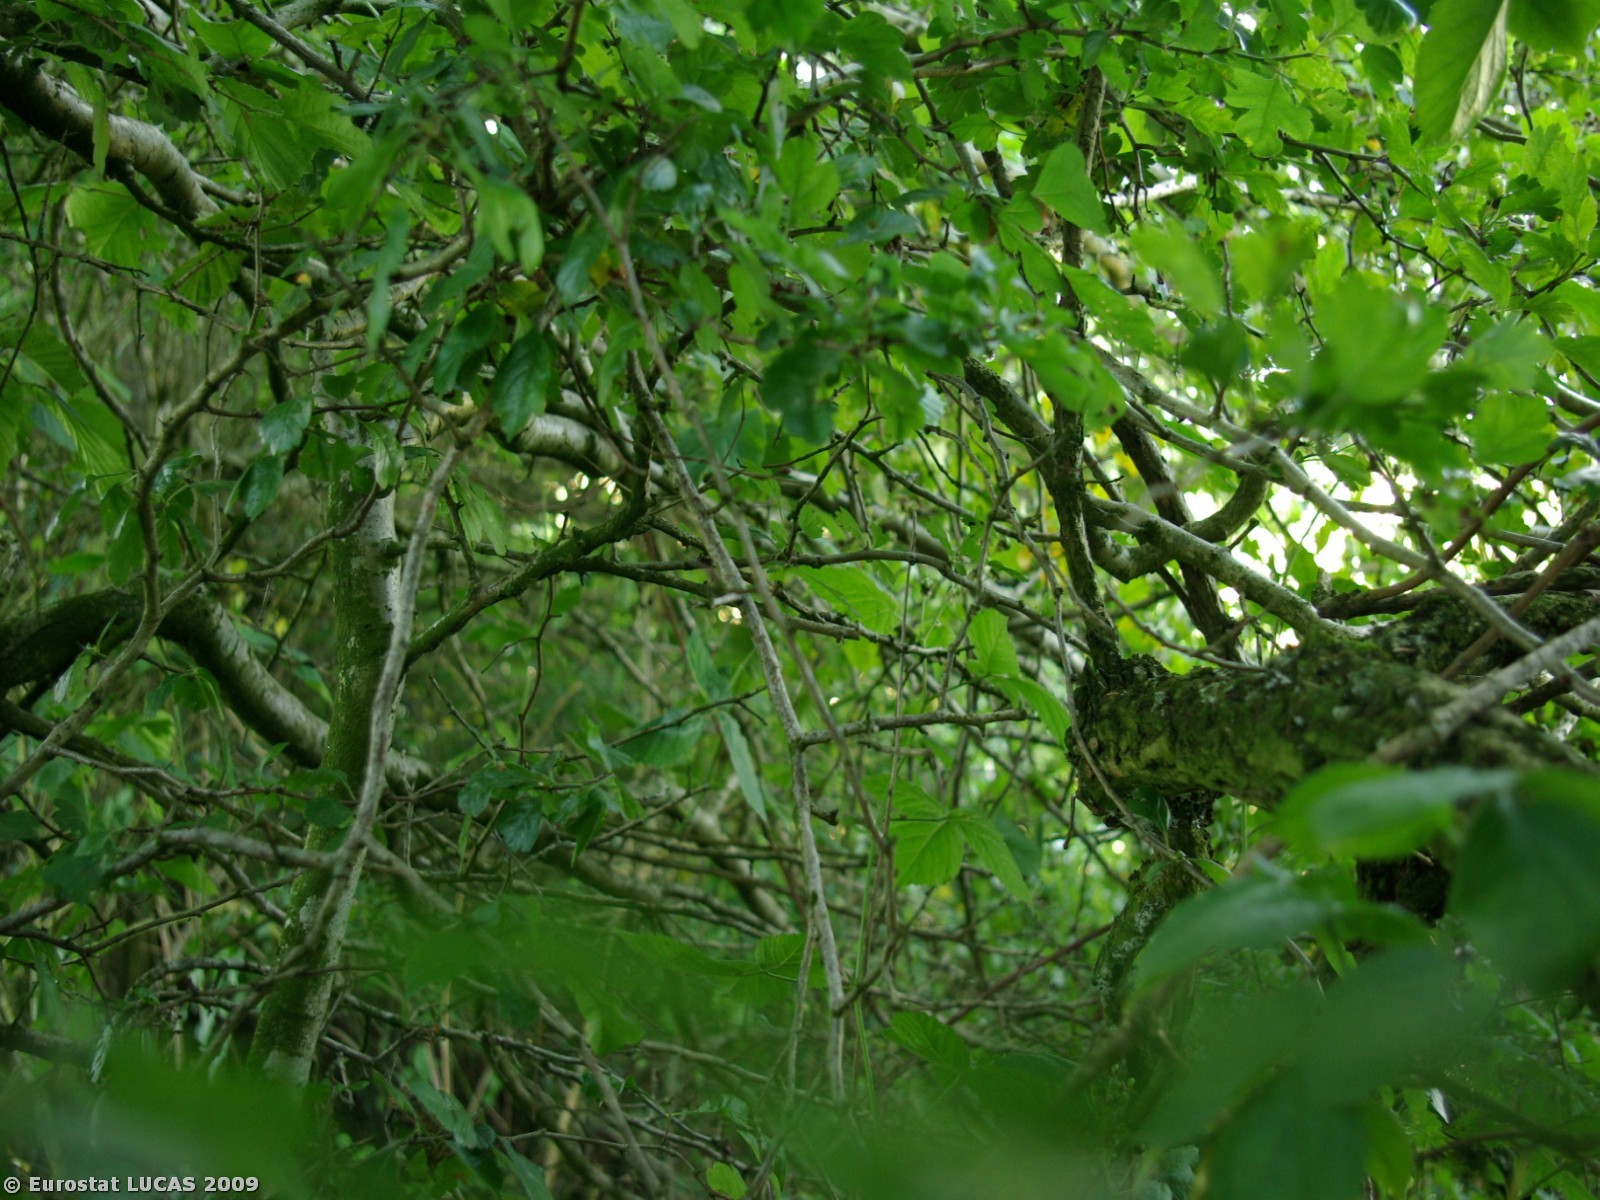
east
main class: Woodland
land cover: Mixed woodland
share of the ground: > 75 %
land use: Unused
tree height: > 5 m
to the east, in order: Mixed woodland; Barley; Spontaneously vegetated surfaces; Grassland without tree/shrub cover
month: July
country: DK
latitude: 54.9815
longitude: 9.2974
